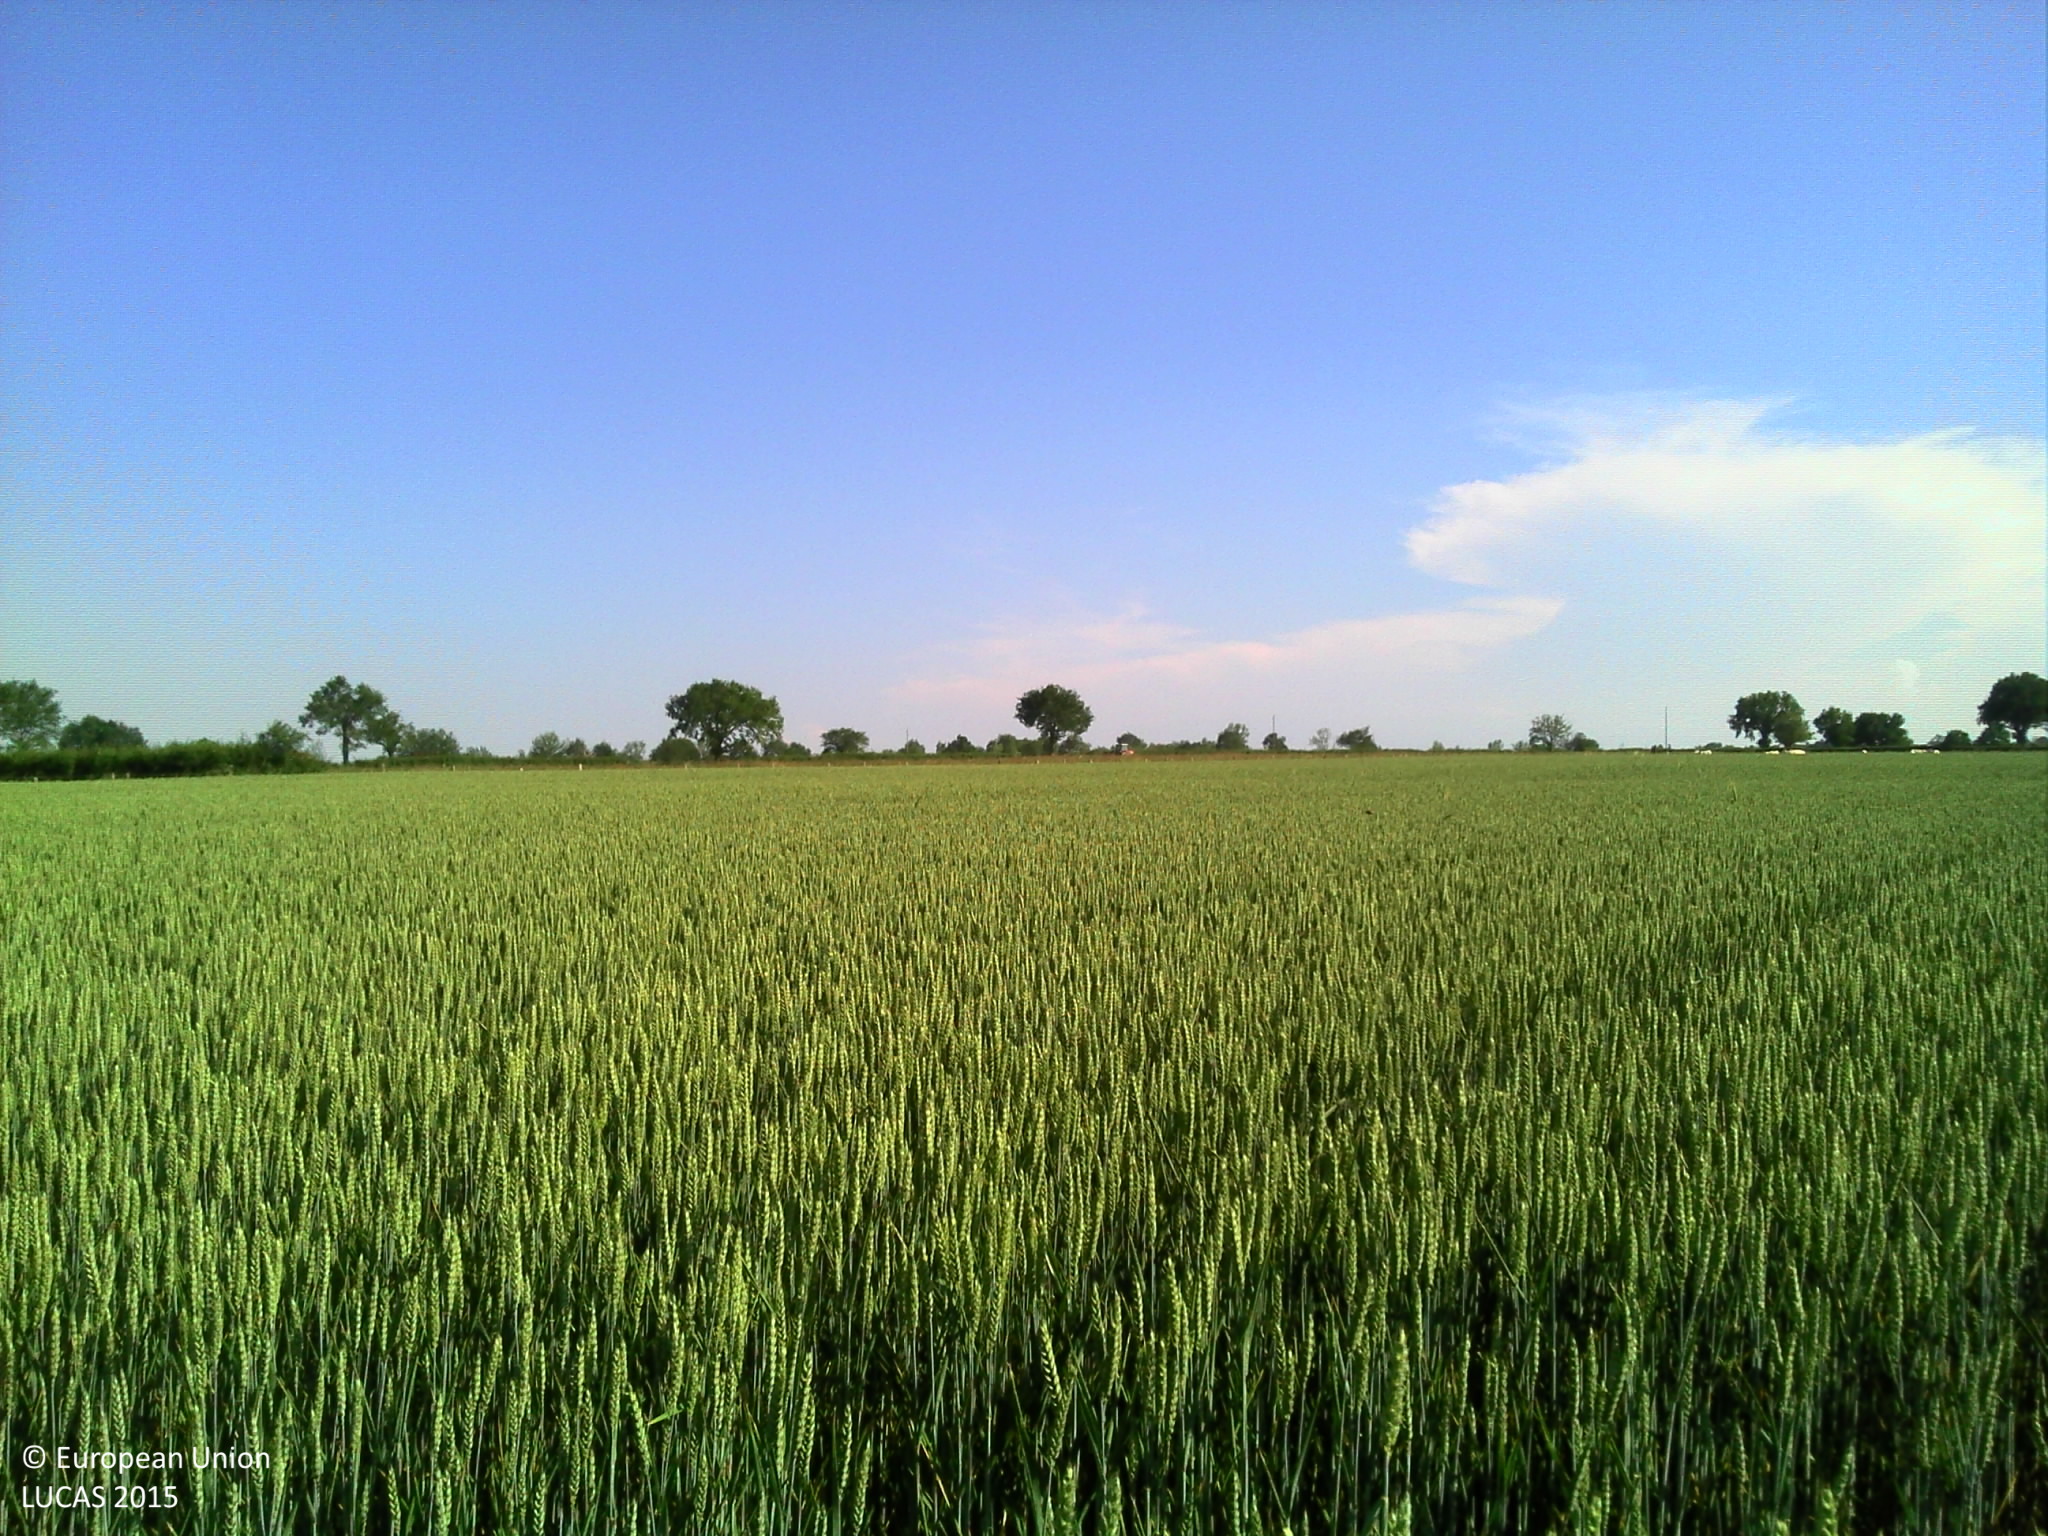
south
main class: Cropland
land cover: Common wheat
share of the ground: > 75 %
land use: Agriculture (excluding fallow land and kitchen gardens)
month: June
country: FR
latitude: 46.3927
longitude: 2.7267
